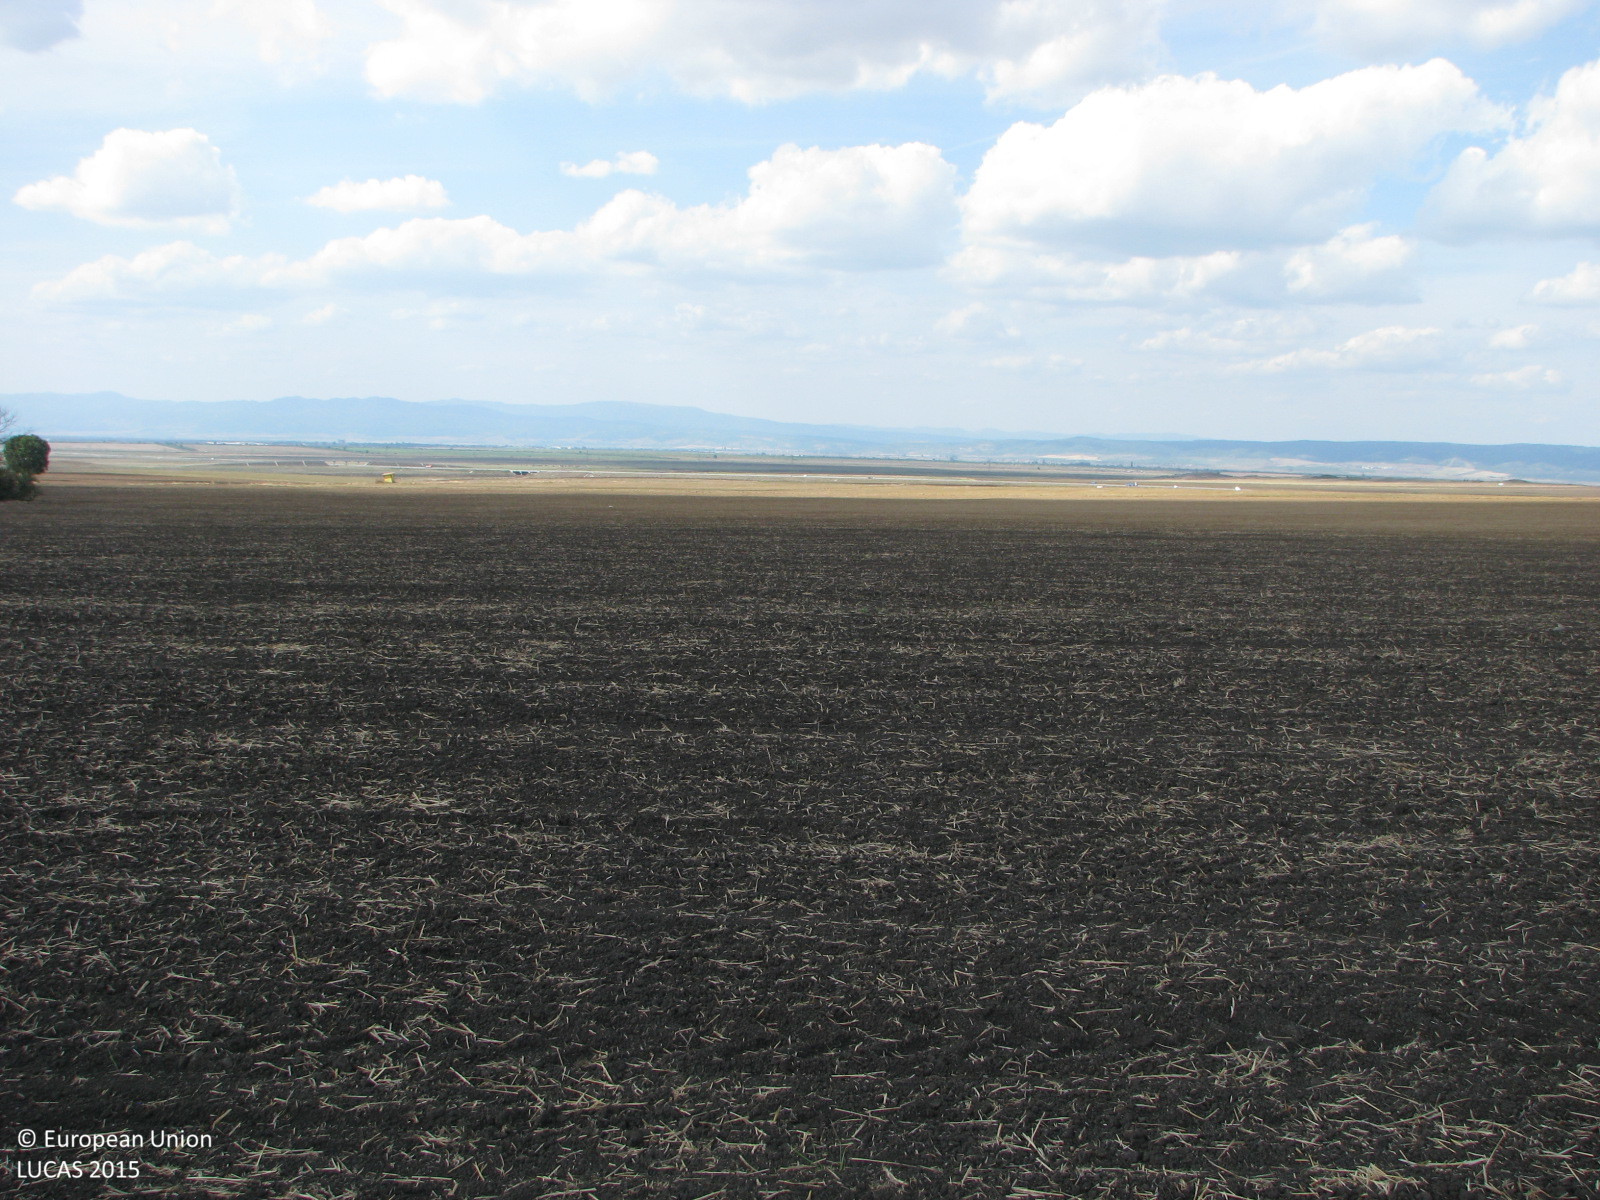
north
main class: Cropland
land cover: Common wheat
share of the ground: < 10 %
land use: Agriculture (excluding fallow land and kitchen gardens)
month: September
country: BG
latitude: 42.5329
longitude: 26.7667
